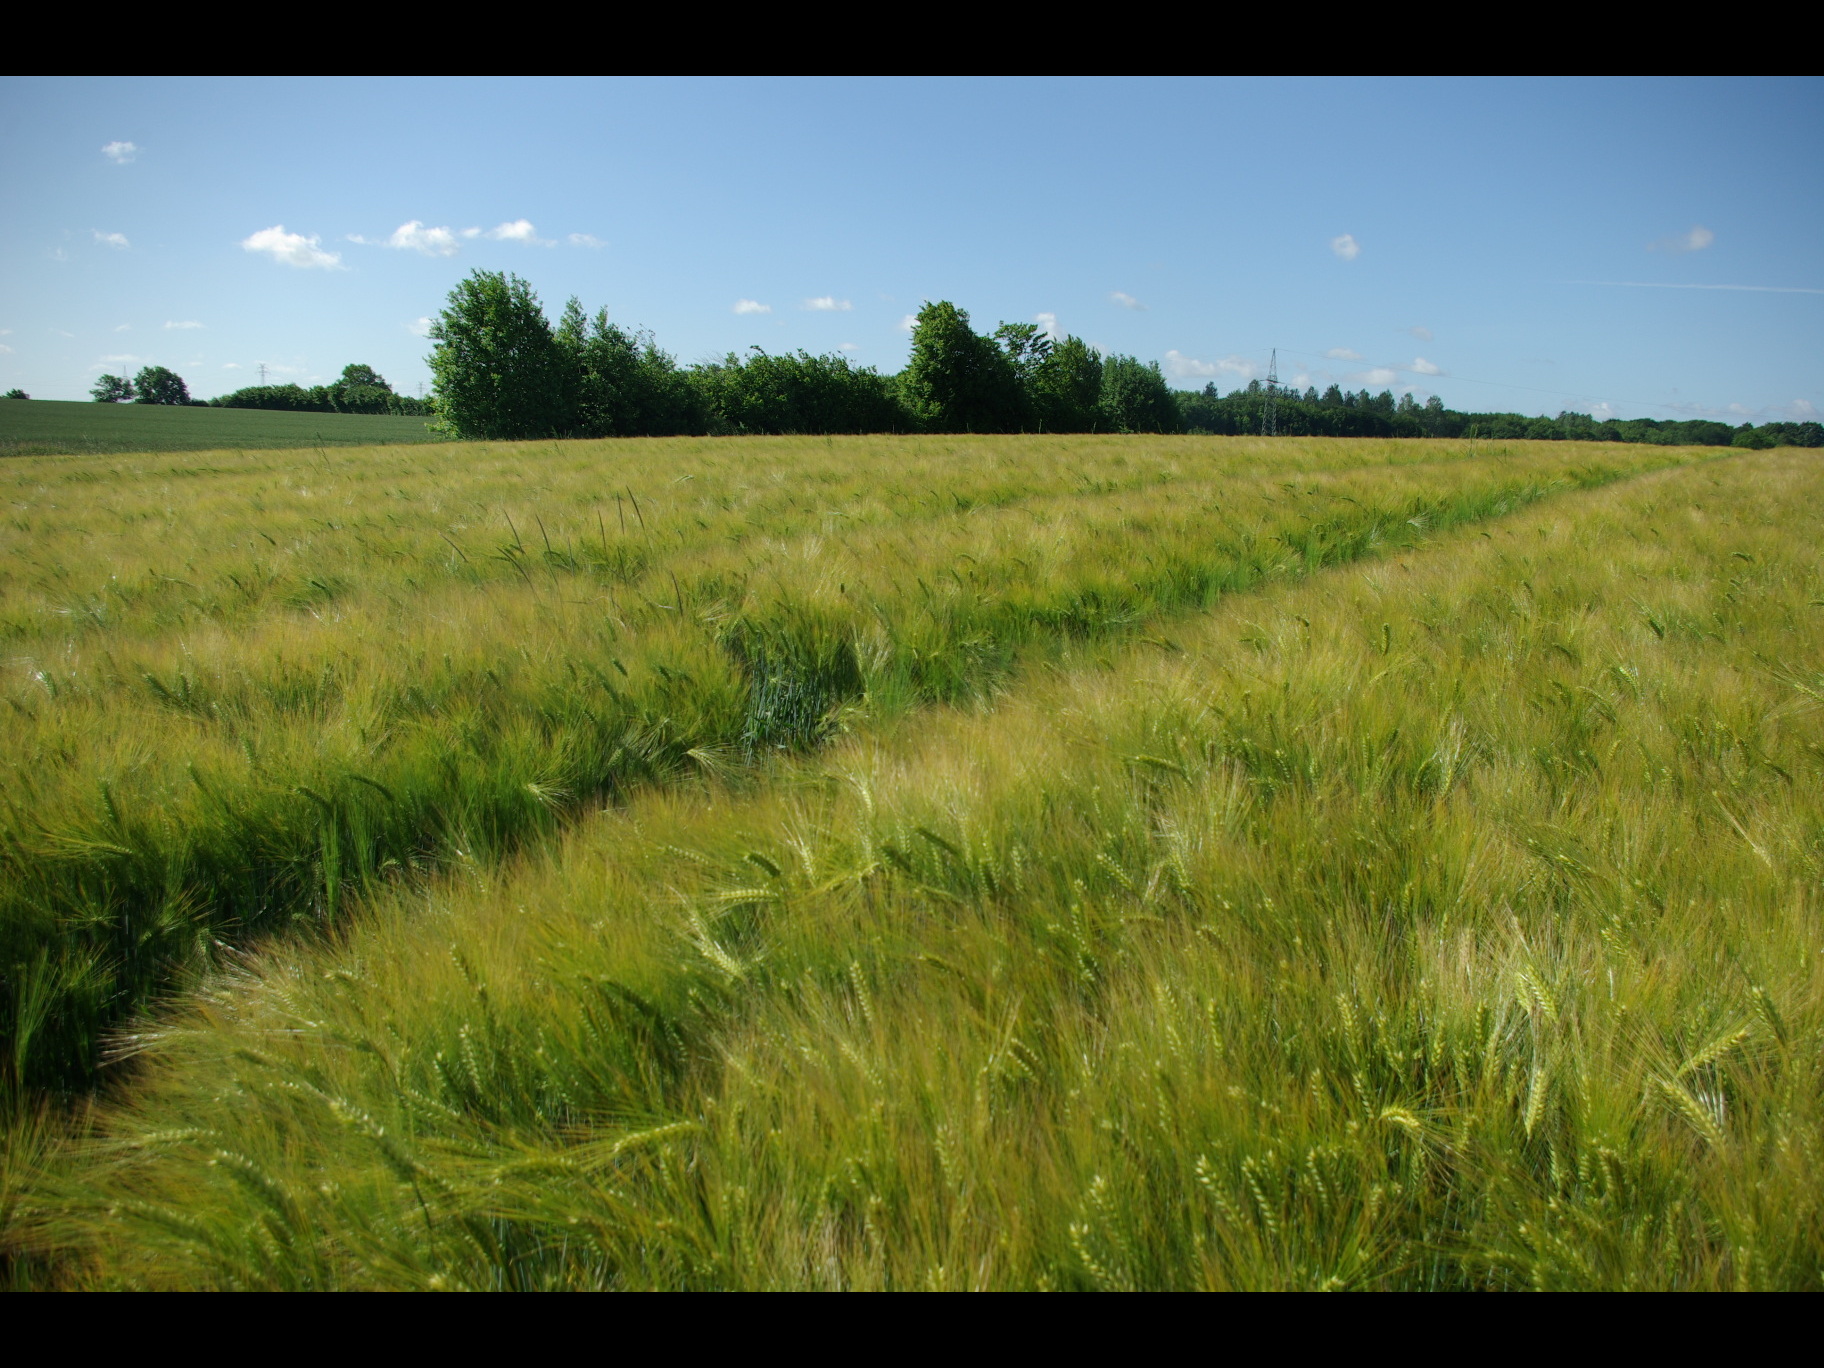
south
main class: Cropland
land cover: Barley
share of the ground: > 75 %
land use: Agriculture (excluding fallow land and kitchen gardens)
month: June
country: DE
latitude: 54.3544
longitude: 9.9231
